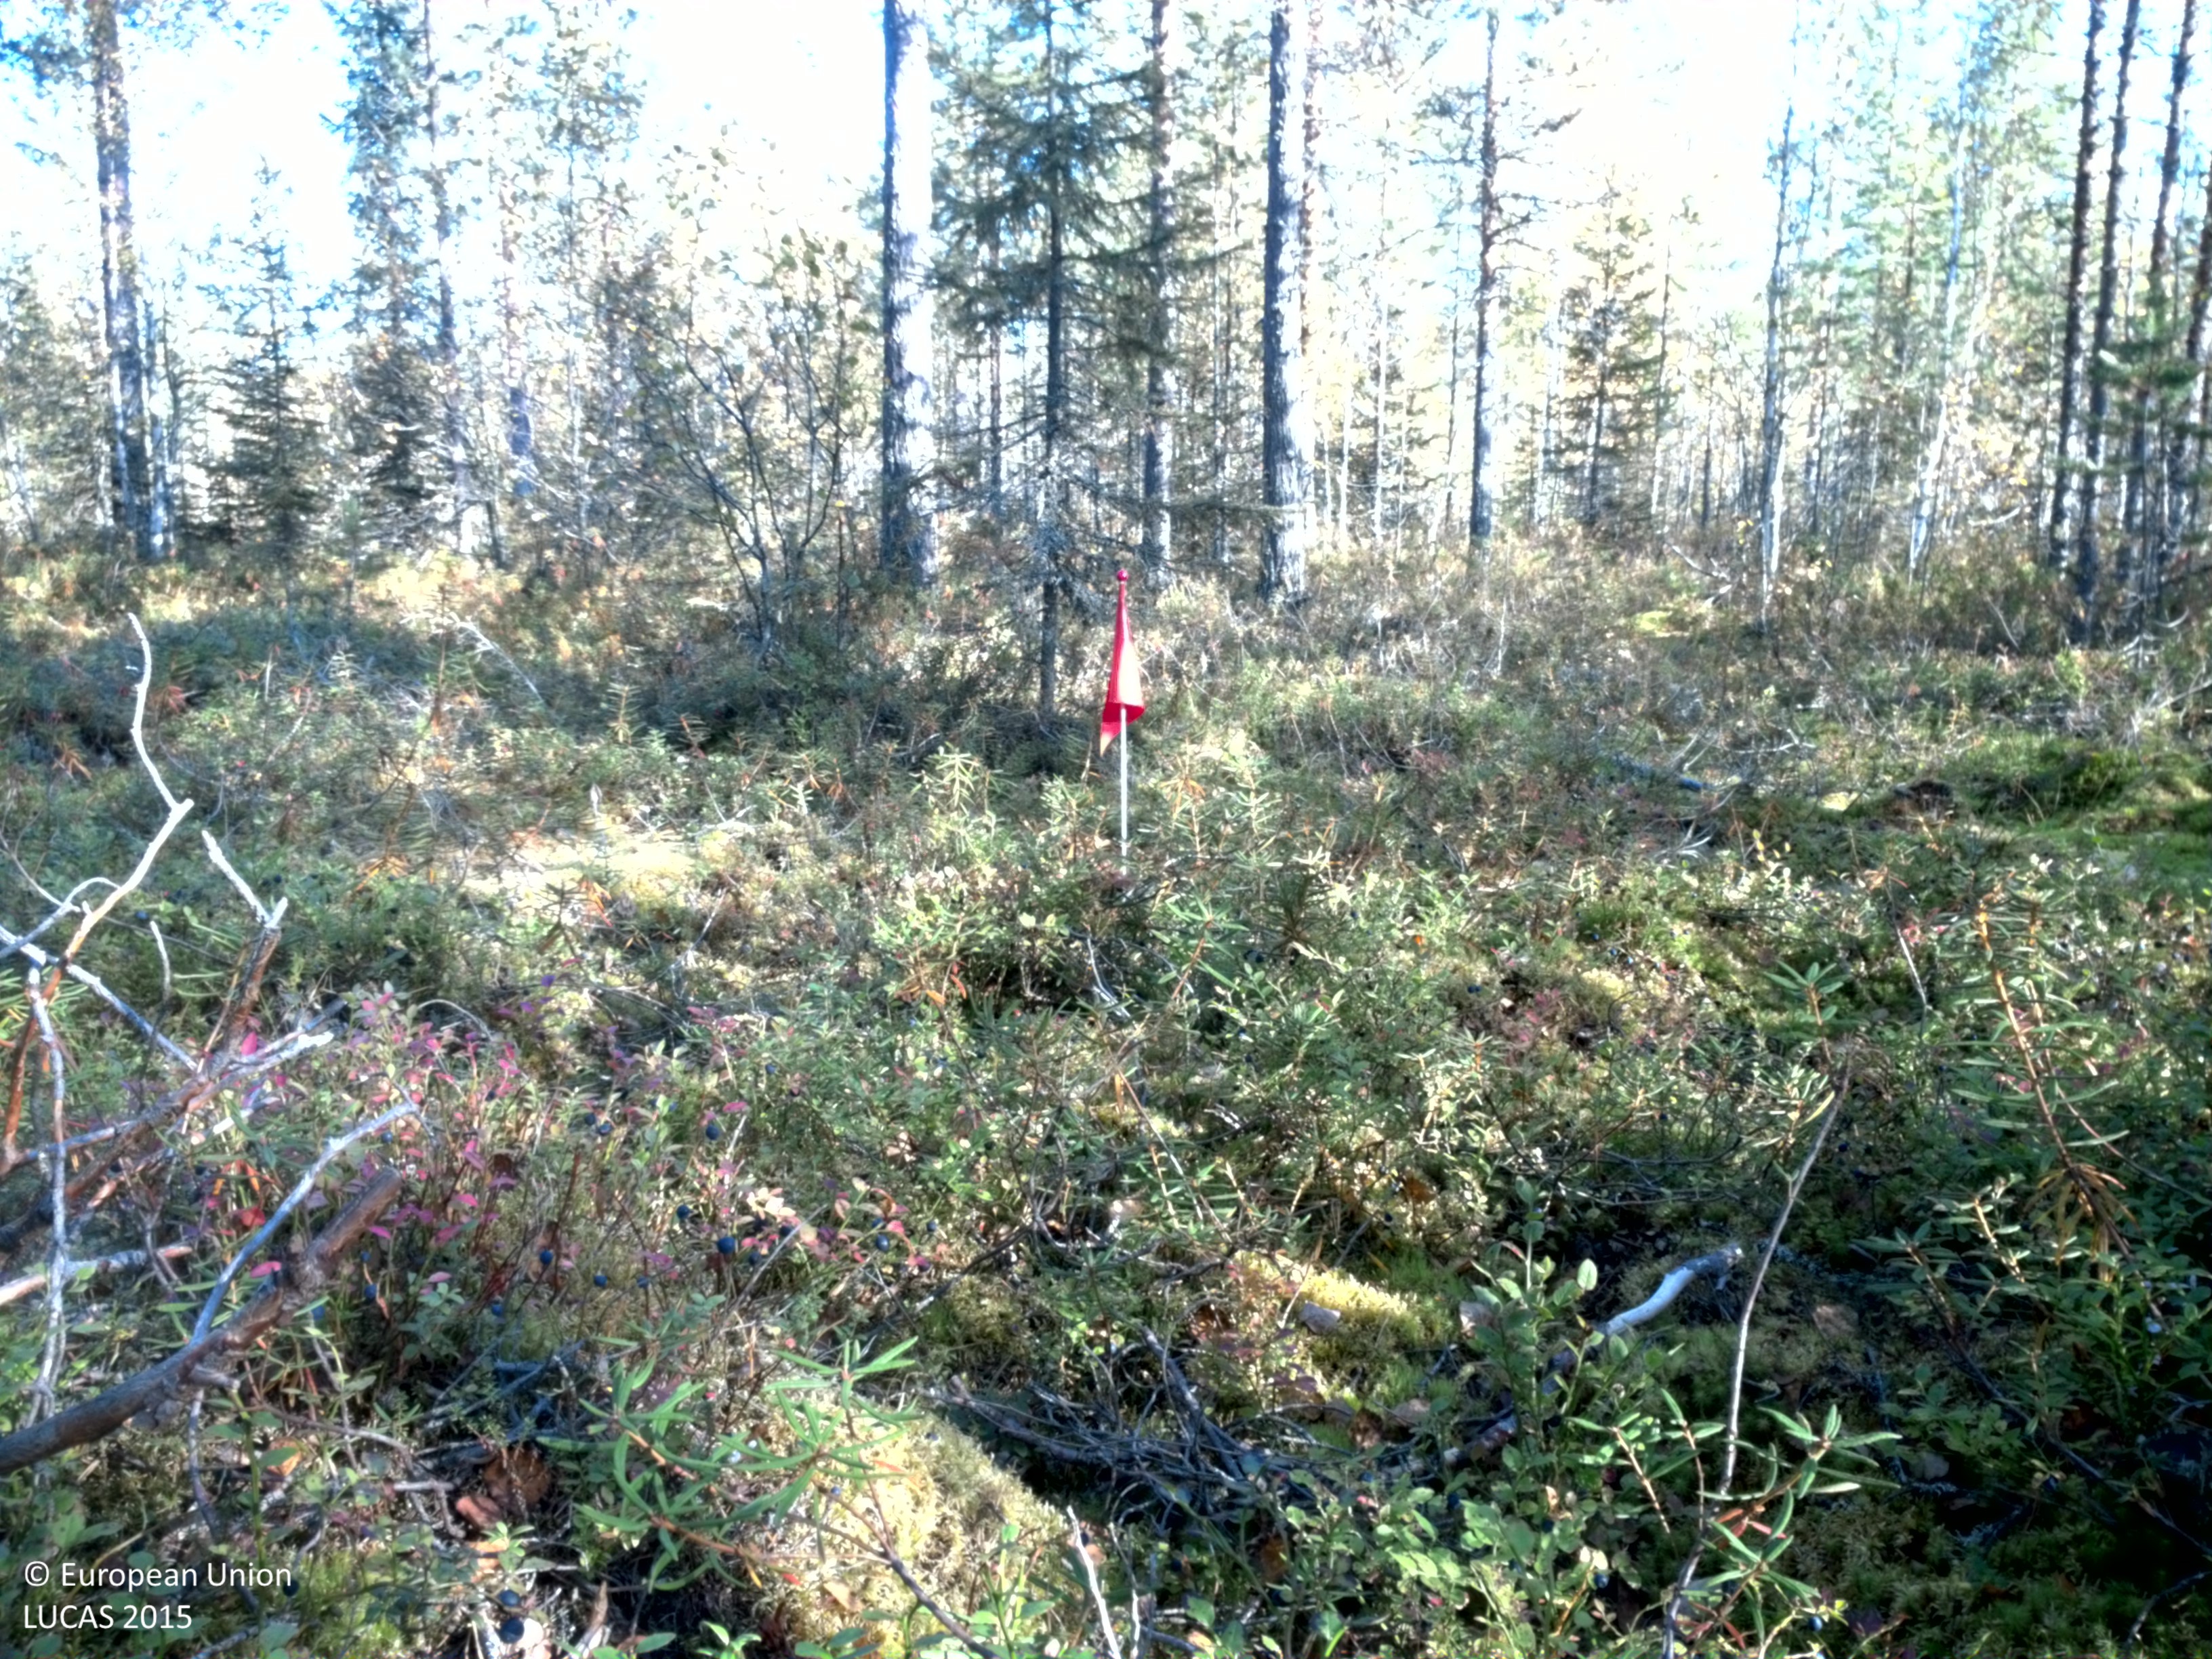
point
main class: Woodland
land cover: Pine dominated mixed woodland
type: boreal forest
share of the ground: 25 - 50 %
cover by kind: shrubs 60 %, coniferous forest trees 25 %, broadleaved forest trees 10 %, lichens and mosses 5 %
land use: Forestry
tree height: > 5 m
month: September
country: SE
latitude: 65.8523
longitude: 22.1787
